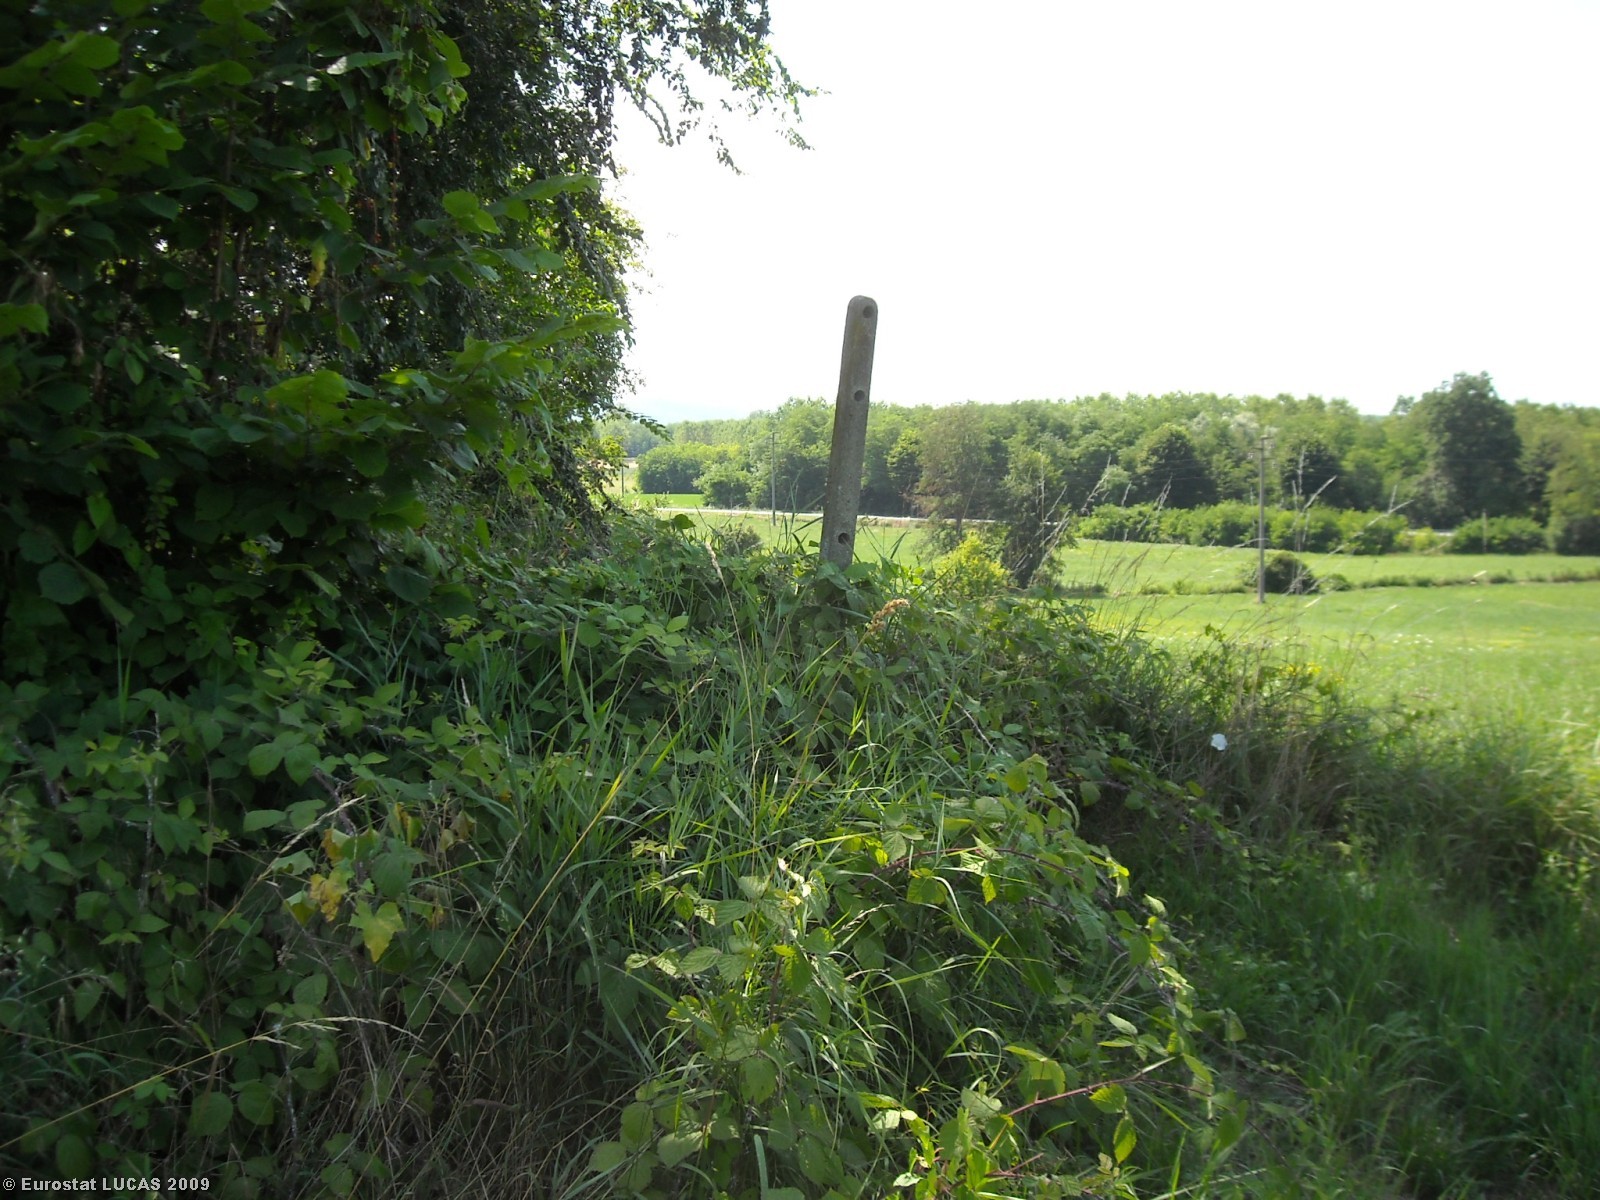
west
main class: Grassland
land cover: Grassland without tree/shrub cover
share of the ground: > 75 %
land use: Agriculture (excluding fallow land and kitchen gardens)
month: June
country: IT
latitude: 45.1625
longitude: 8.0824
